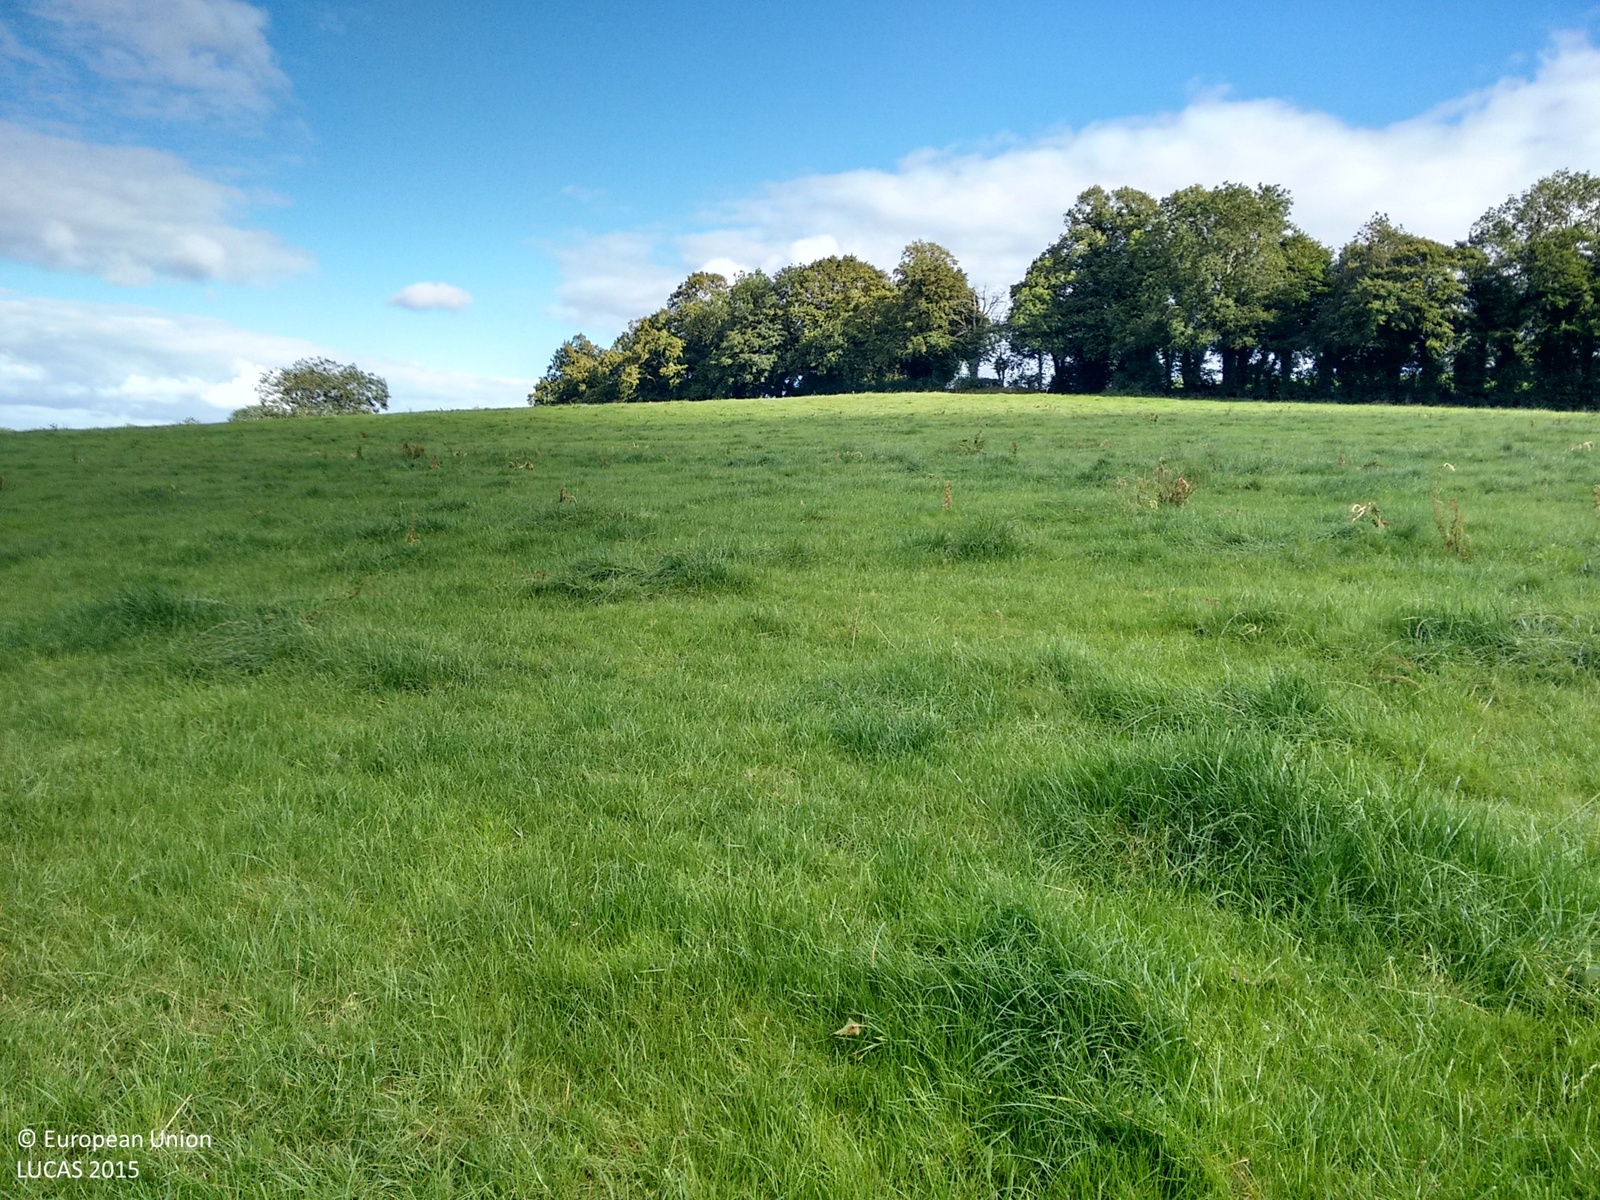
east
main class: Grassland
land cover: Grassland without tree/shrub cover
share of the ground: > 75 %
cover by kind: herbaceous plants 100 %
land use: Agriculture (excluding fallow land and kitchen gardens)
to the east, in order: Managed hedges; Grassland without tree/shrub cover; Fences; Managed hedges; Tracks; Fences; Grassland with sparse tree/shrub cover; Fences; Grassland with sparse tree/shrub cover; Fences; Grassland without tree/shrub cover
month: September
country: IE
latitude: 54.2119
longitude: -6.8652
